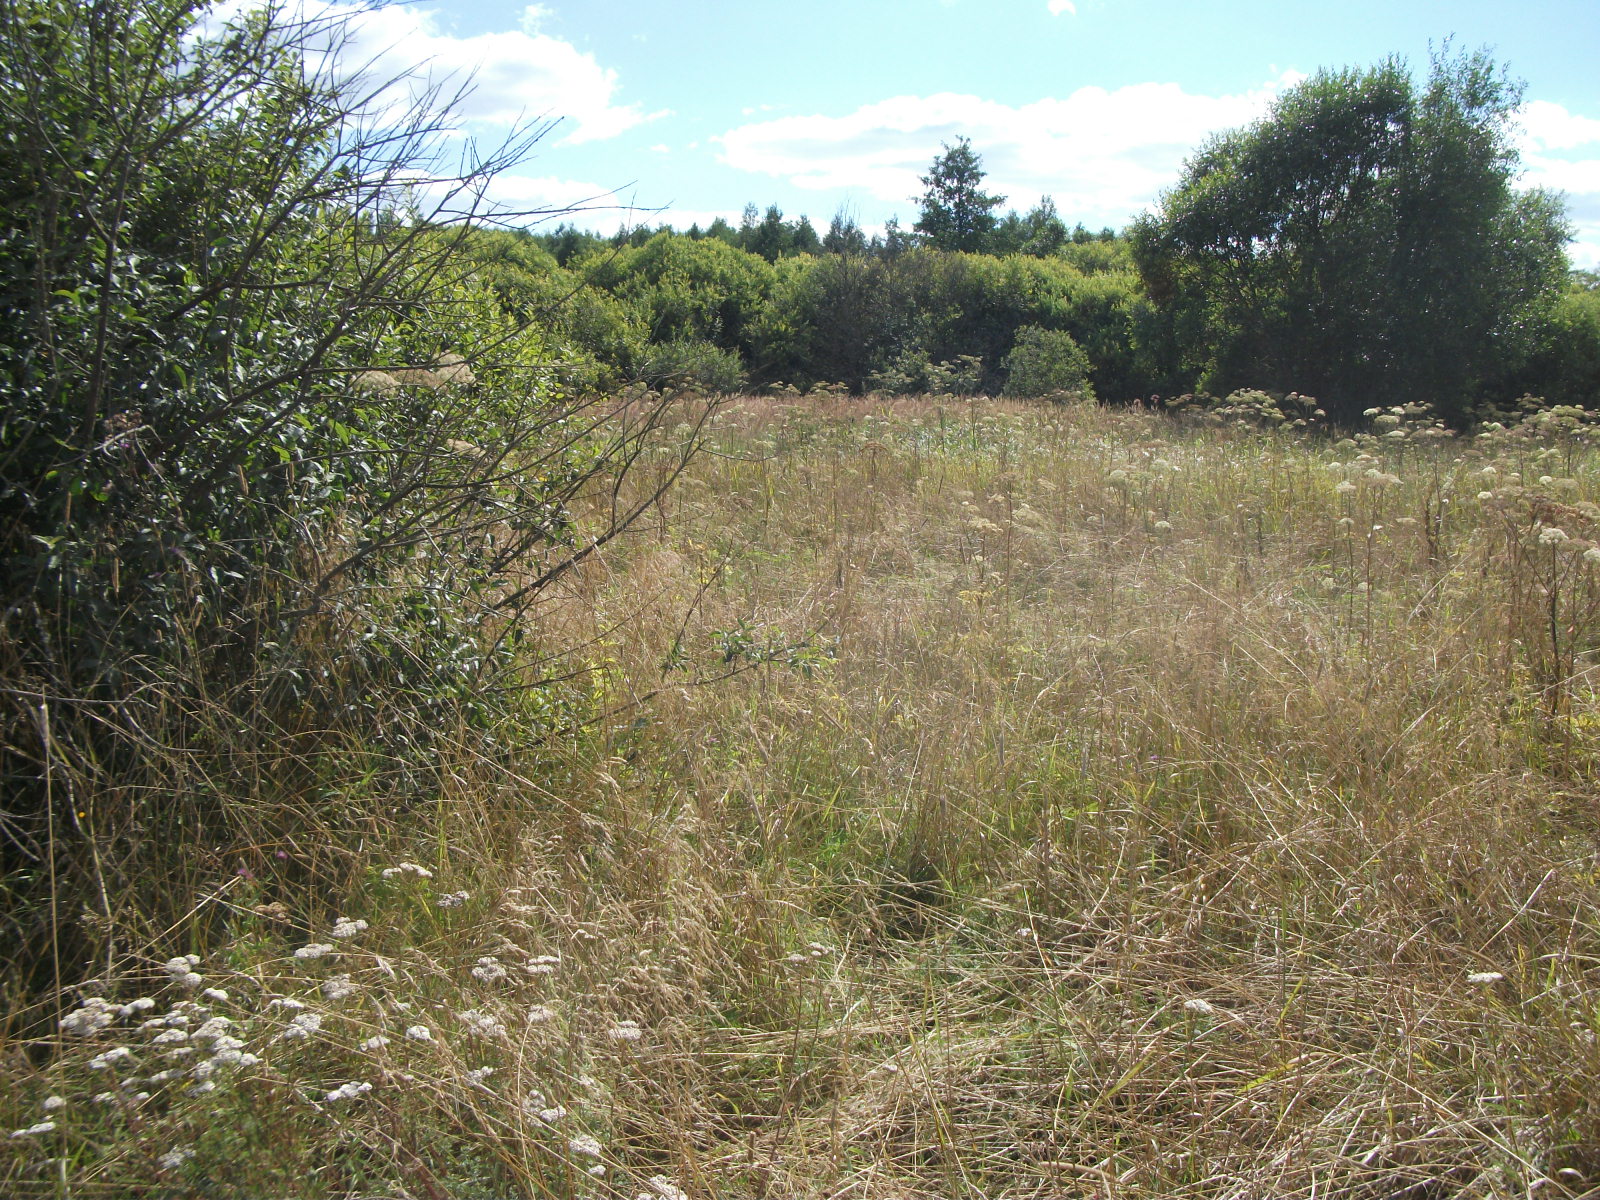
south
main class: Grassland
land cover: Grassland with sparse tree/shrub cover
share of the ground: > 75 %
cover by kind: herbaceous plants 85 %, shrubs 10 %, broadleaved forest trees 5 %
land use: Abandoned areas
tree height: < 5 m
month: August
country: LV
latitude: 56.4095
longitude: 26.4007
